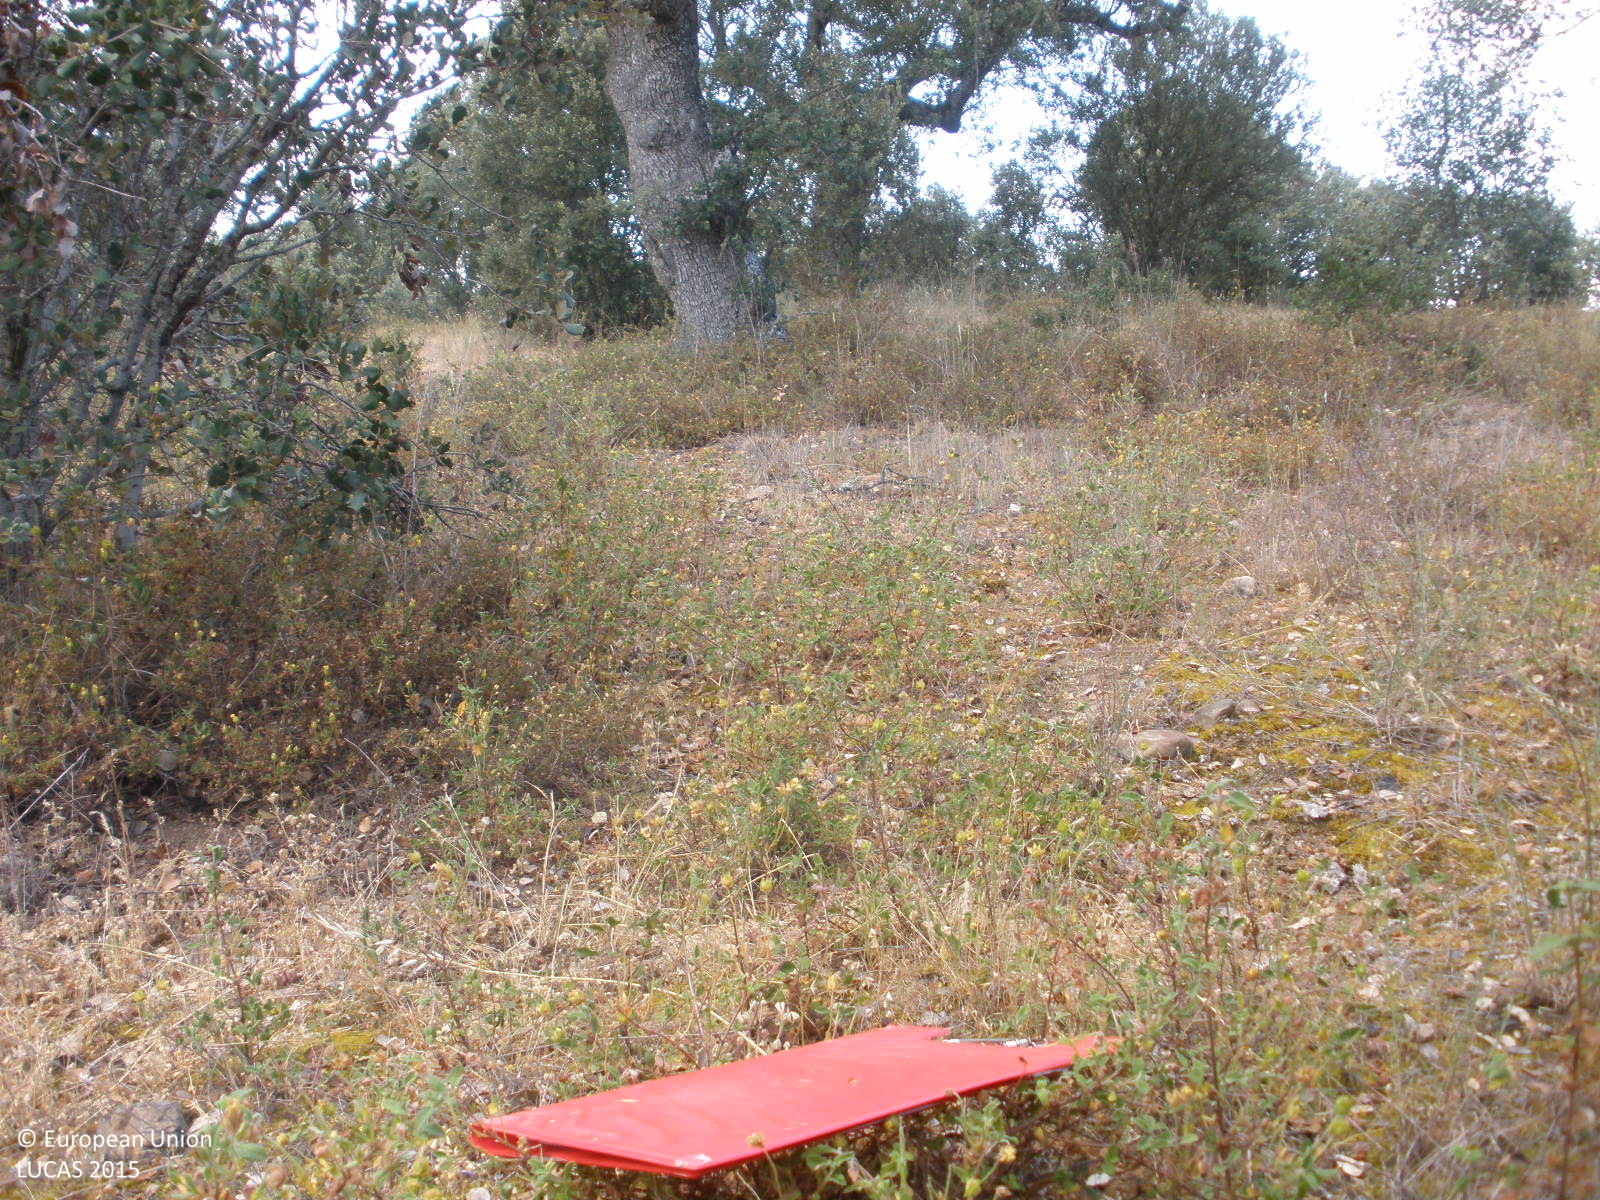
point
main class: Woodland
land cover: Broadleaved woodland
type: broadleaved evergreen forest
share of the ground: > 75 %
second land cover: Shrubland without tree cover
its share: 25 - 50 %
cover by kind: broadleaved forest trees 70 %, shrubs 30 %
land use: Forestry
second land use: Agriculture (excluding fallow land and kitchen gardens)
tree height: > 5 m
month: June
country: ES
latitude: 40.7505
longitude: -6.2047
